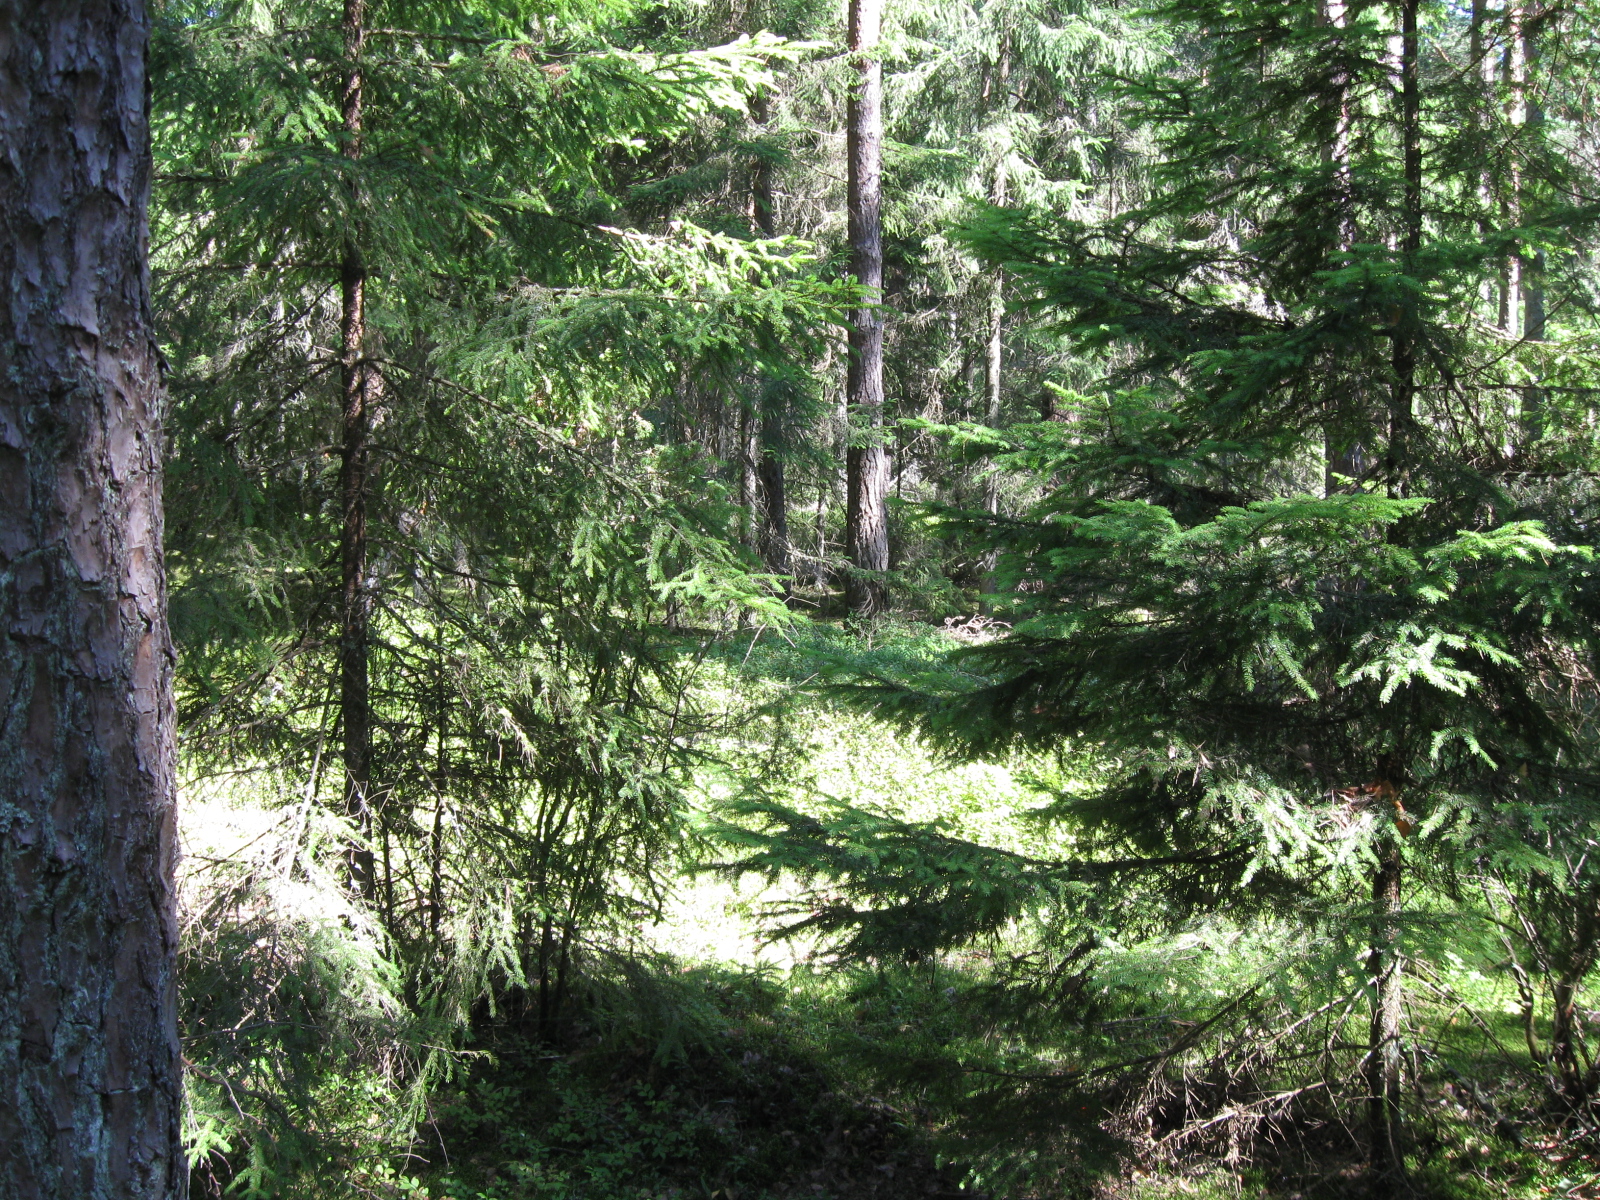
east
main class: Woodland
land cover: Other coniferous woodland
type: hemiboreal forest and nemoral coniferous forest and mixed broadleaved-coniferous forest
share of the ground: > 75 %
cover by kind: coniferous forest trees 85 %, lichens and mosses 10 %, shrubs 5 %
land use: Forestry
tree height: > 5 m
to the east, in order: Other coniferous woodland; Paved roads, cycling and walking lanes; Pine dominated coniferous woodland; Other structural elements; Pine dominated coniferous woodland; Other coniferous woodland
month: August
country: LT
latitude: 54.9416
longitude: 23.4898
